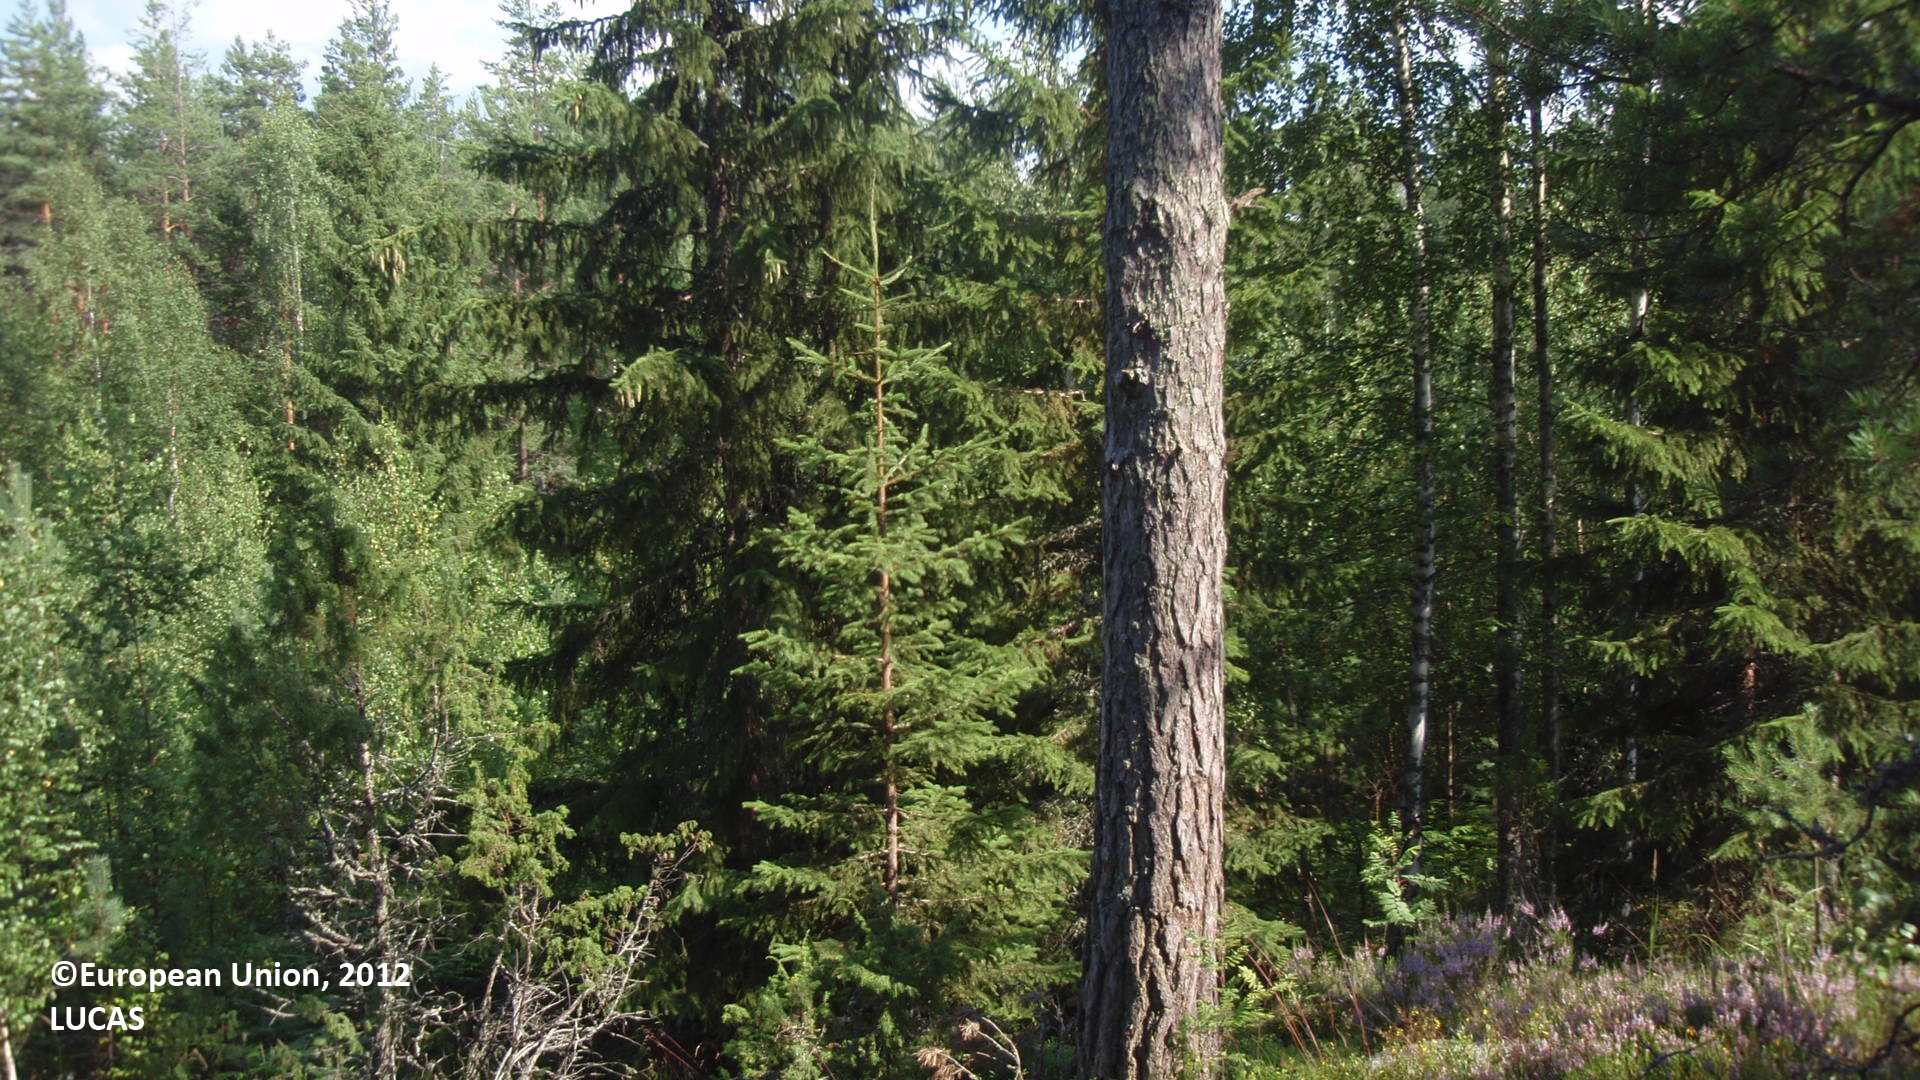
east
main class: Woodland
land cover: Pine dominated mixed woodland
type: boreal forest
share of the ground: 25 - 50 %
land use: Forestry
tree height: > 5 m
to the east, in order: Pine dominated mixed woodland; Broadleaved woodland; Pine dominated coniferous woodland; Pine dominated mixed woodland; Tracks; Pine dominated mixed woodland; Inland marshes
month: July
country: FI
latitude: 61.3796
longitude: 28.4582
